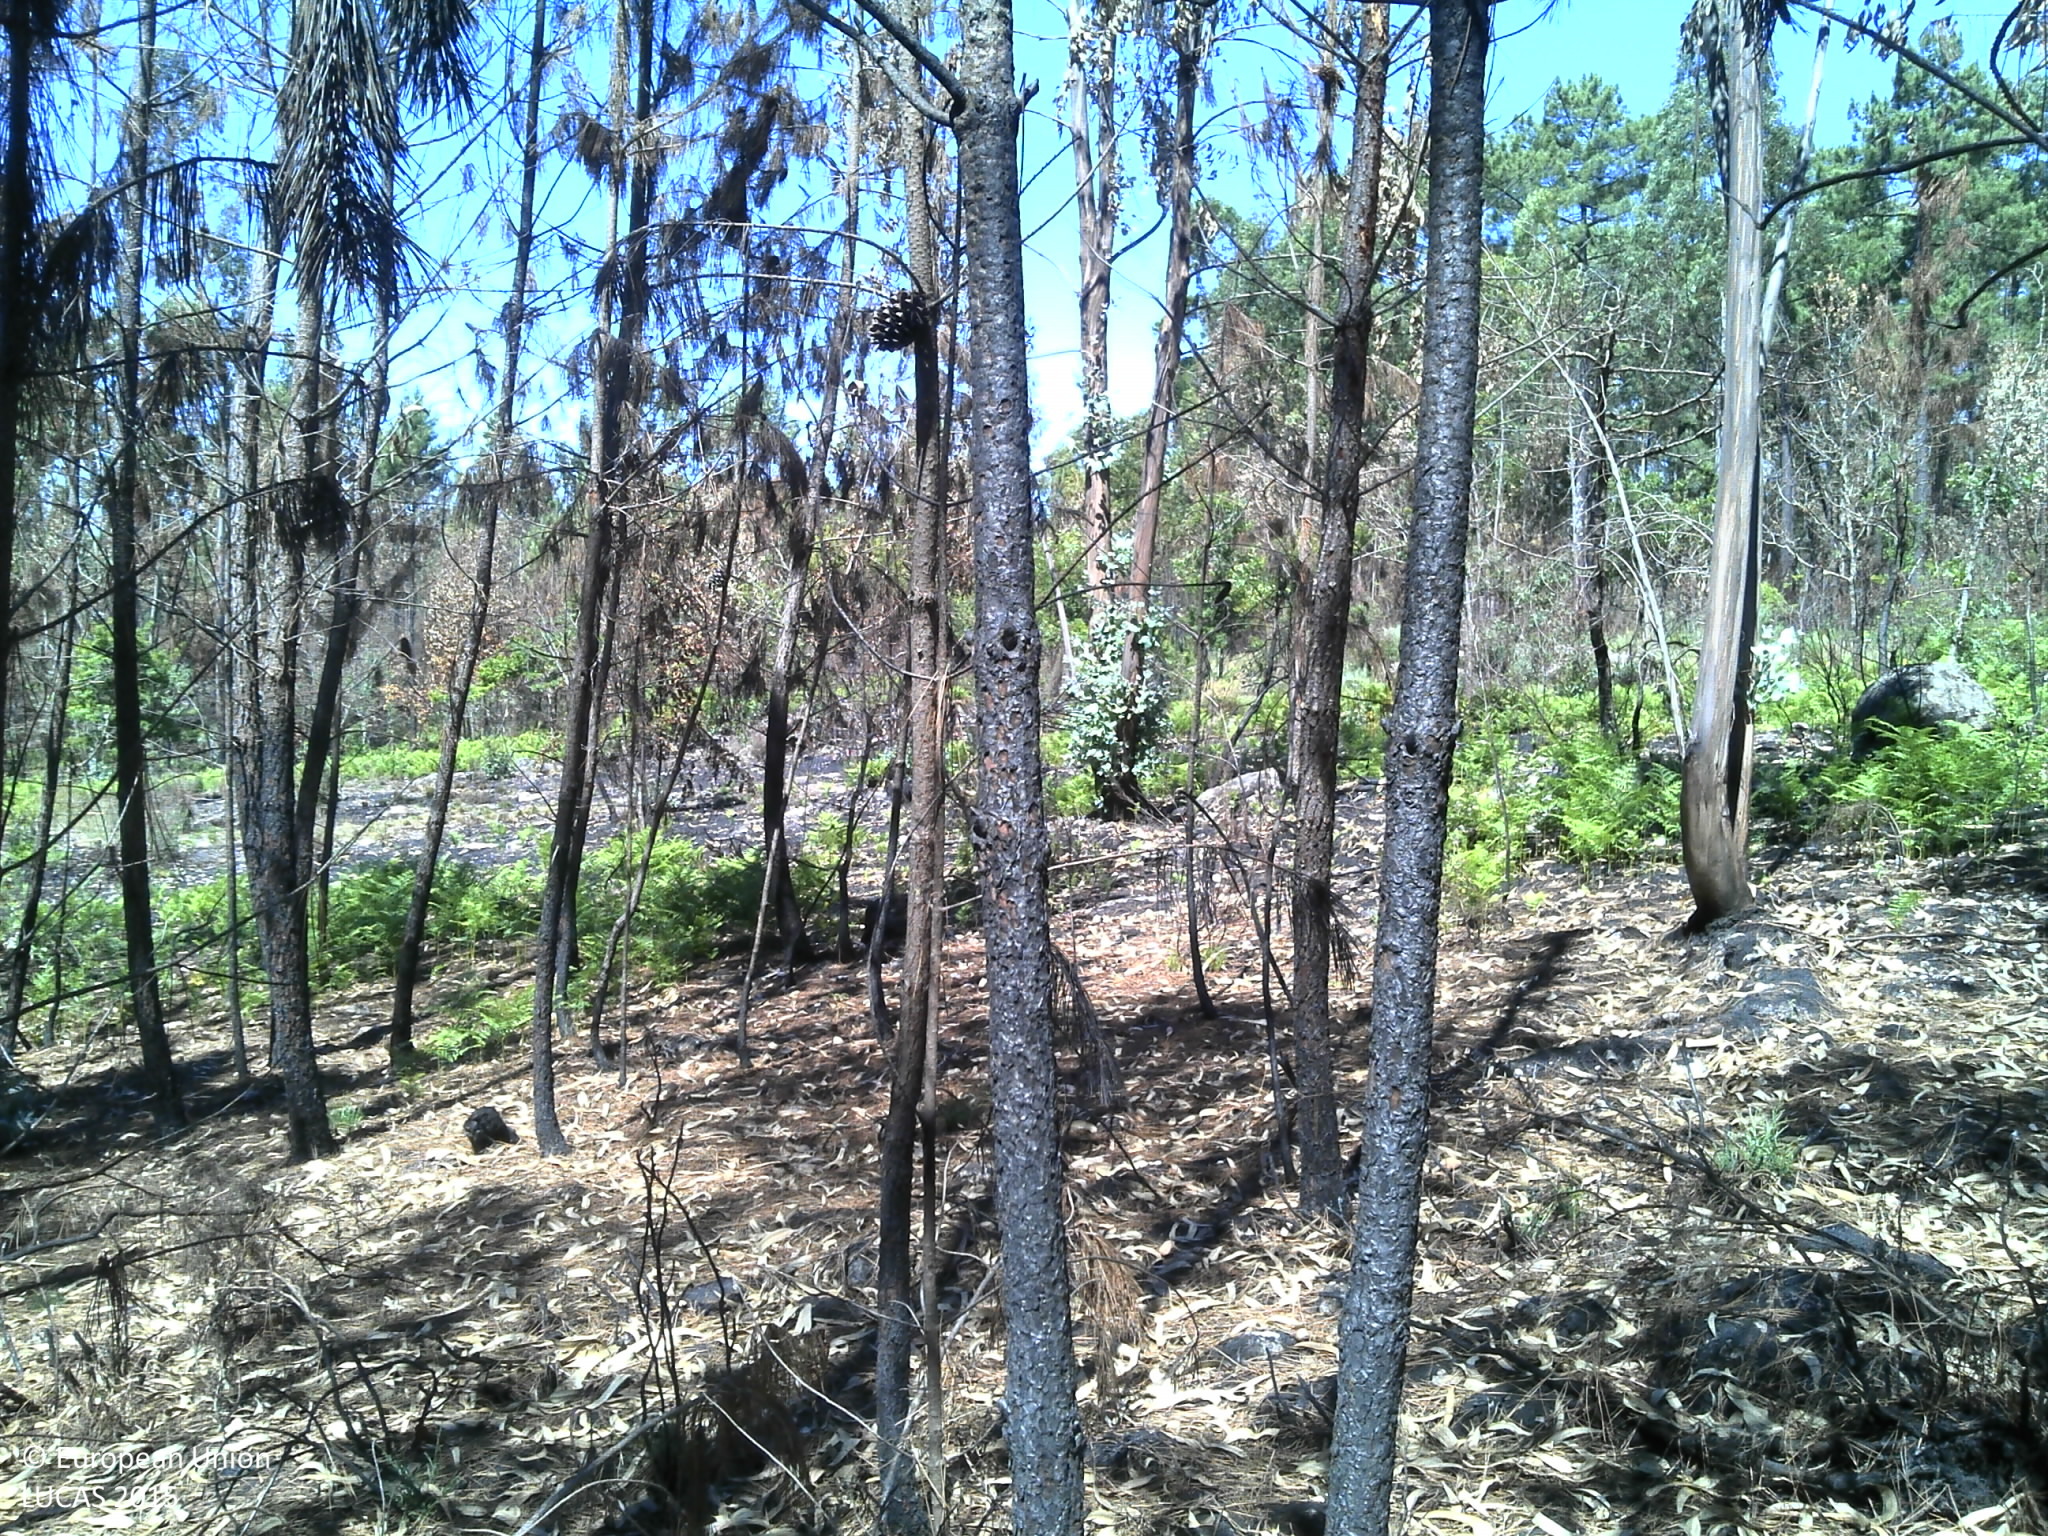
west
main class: Woodland
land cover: Pine dominated mixed woodland
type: coniferous forest of the mediterranean region
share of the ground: 50 - 75 %
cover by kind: coniferous forest trees 50 %, broadleaved forest trees 25 %, unconsolidated bare surface 20 %, consolidated bare surface 5 %
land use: Forestry
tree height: > 5 m
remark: Burnt area
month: June
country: PT
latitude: 40.6525
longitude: -8.0208
